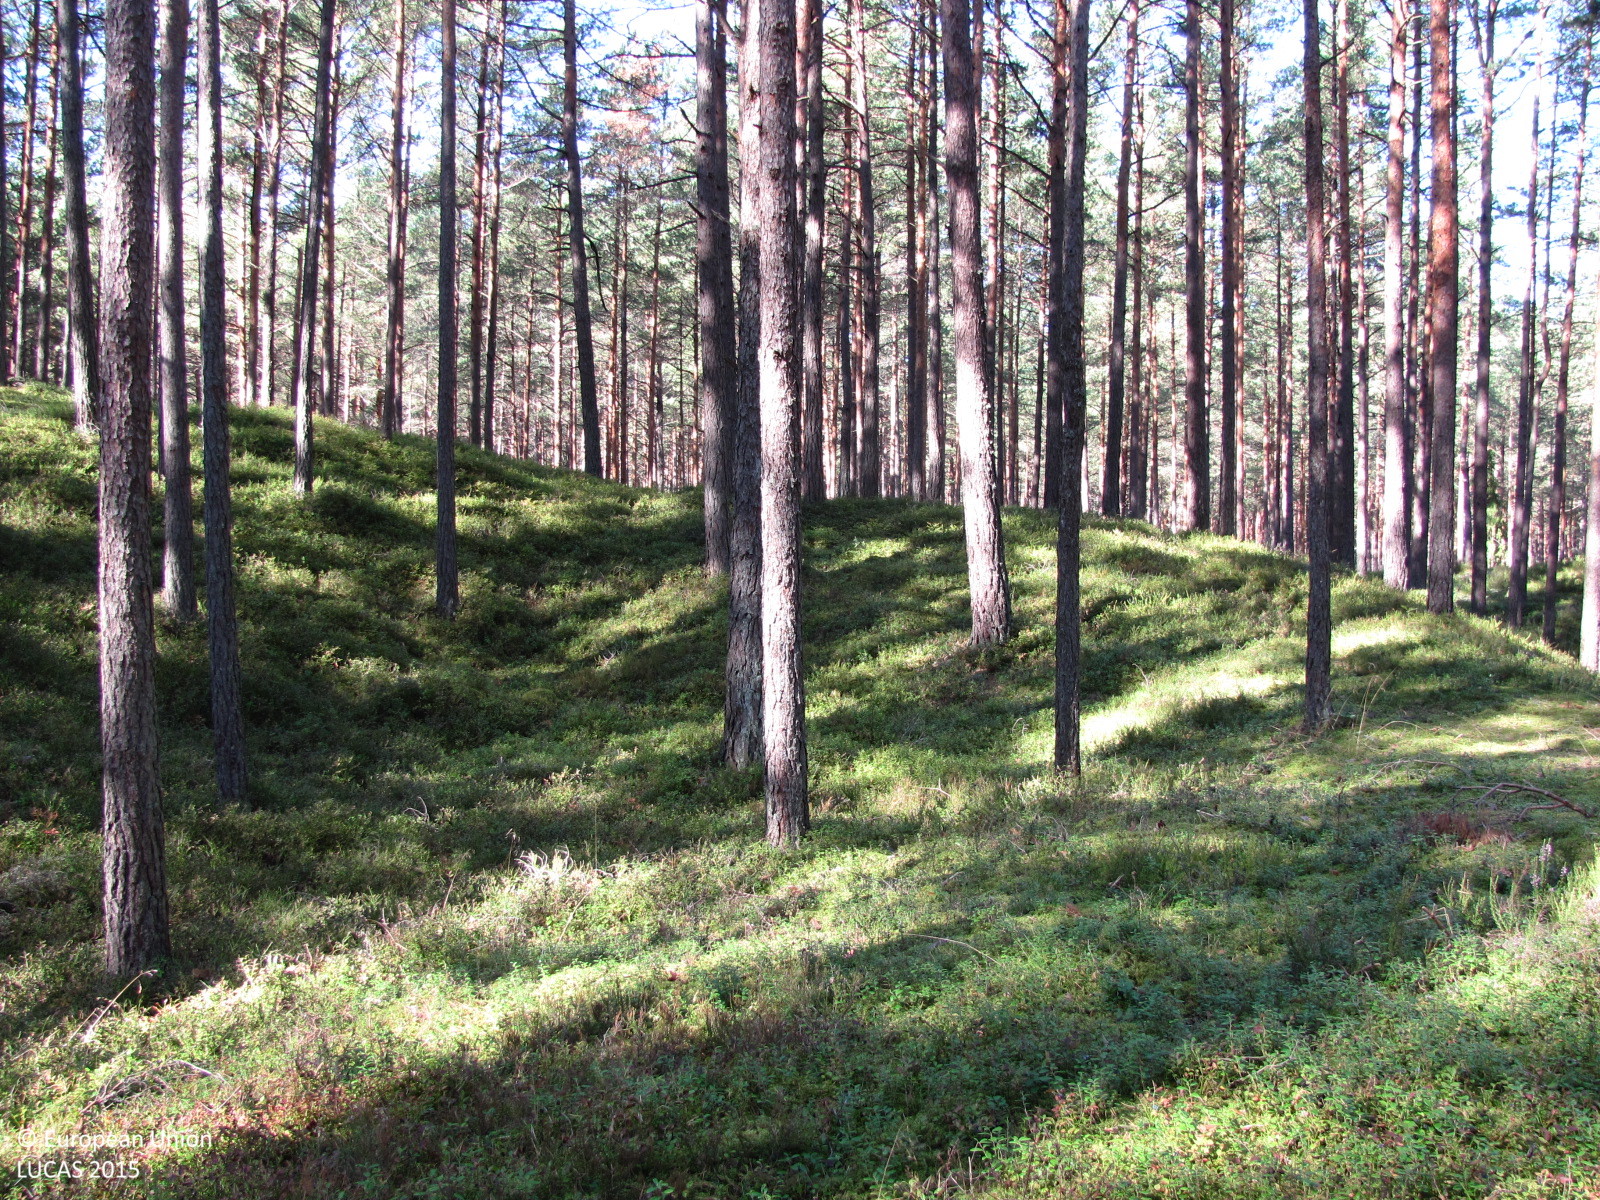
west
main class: Woodland
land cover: Pine dominated coniferous woodland
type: hemiboreal forest and nemoral coniferous forest and mixed broadleaved-coniferous forest
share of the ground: > 75 %
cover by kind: coniferous forest trees 80 %, herbaceous plants 10 %, lichens and mosses 10 %
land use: Forestry
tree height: > 5 m
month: September
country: LV
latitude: 57.1117
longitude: 24.2046
